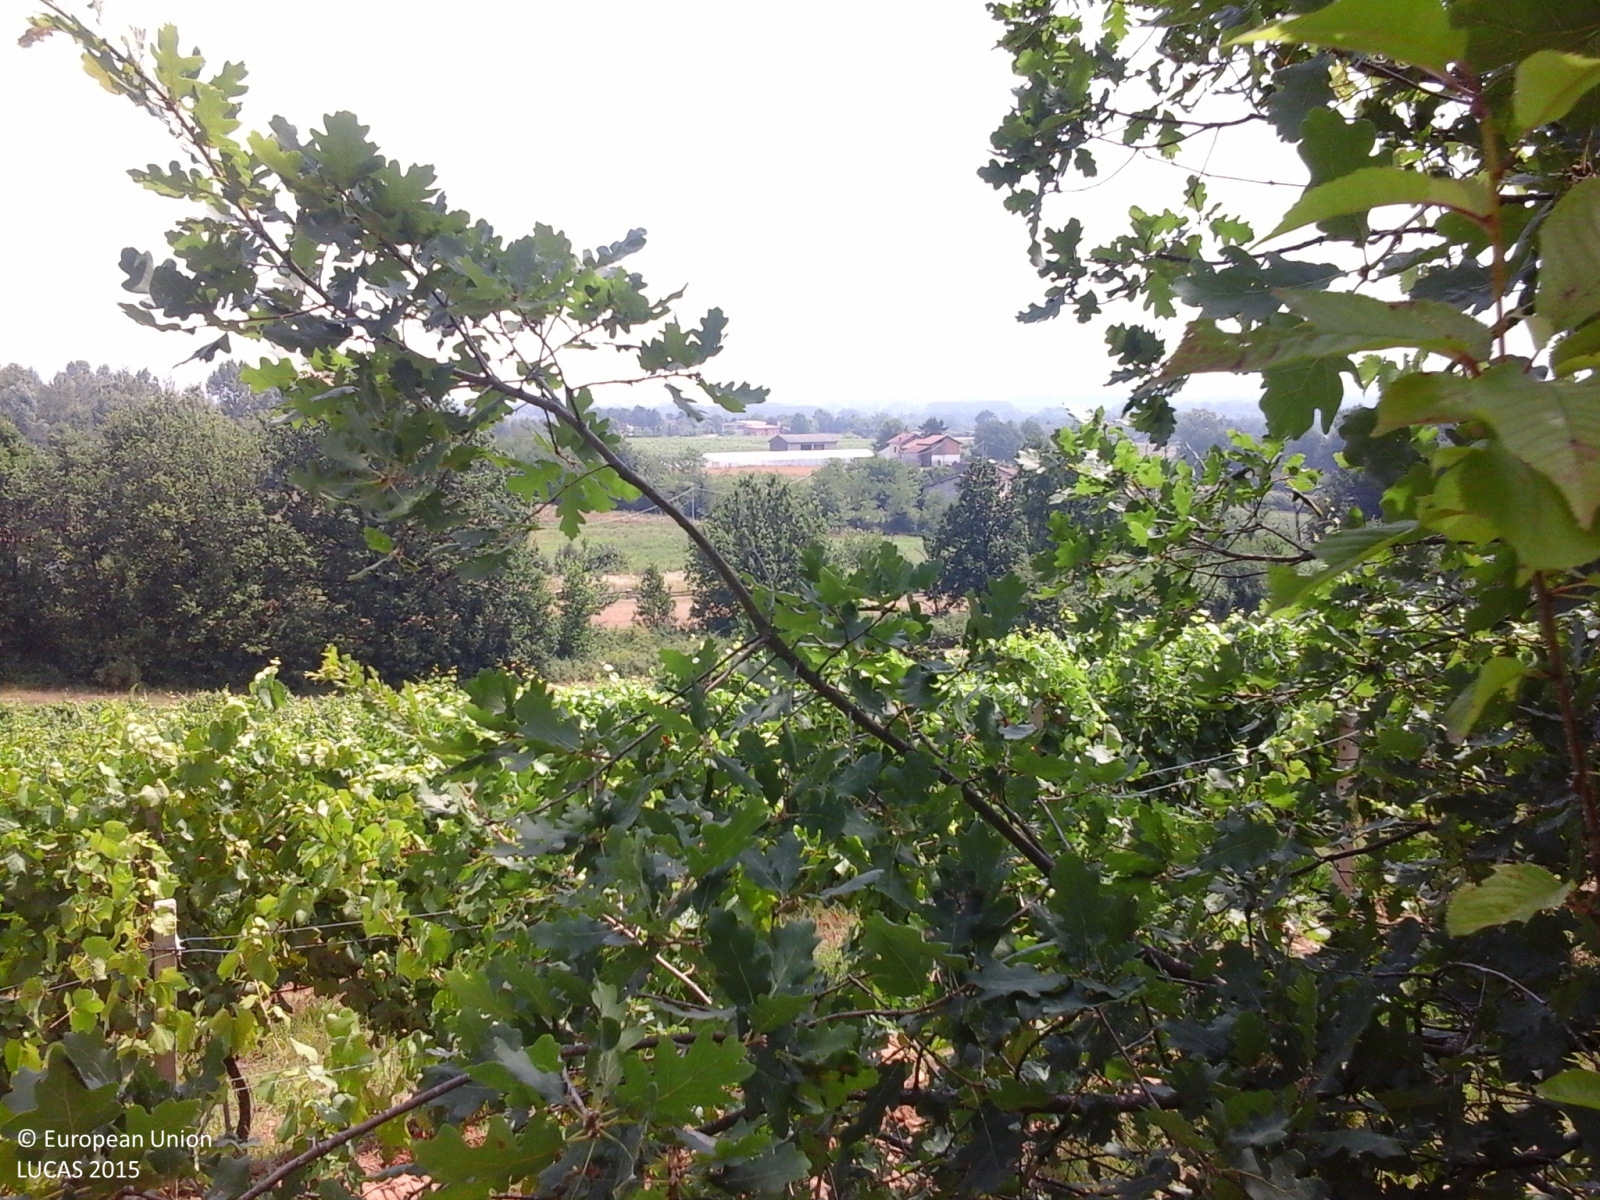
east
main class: Woodland
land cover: Broadleaved woodland
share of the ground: > 75 %
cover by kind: broadleaved forest trees 70 %, shrubs 20 %, herbaceous plants 10 %
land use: Semi-natural and natural areas not in use
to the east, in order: Broadleaved woodland; Vineyards; Tracks; Grassland without tree/shrub cover; Broadleaved woodland; Tracks; Broadleaved woodland; Grassland without tree/shrub cover; Tracks; Sunflower
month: July
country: IT
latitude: 44.7729
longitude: 8.5246
